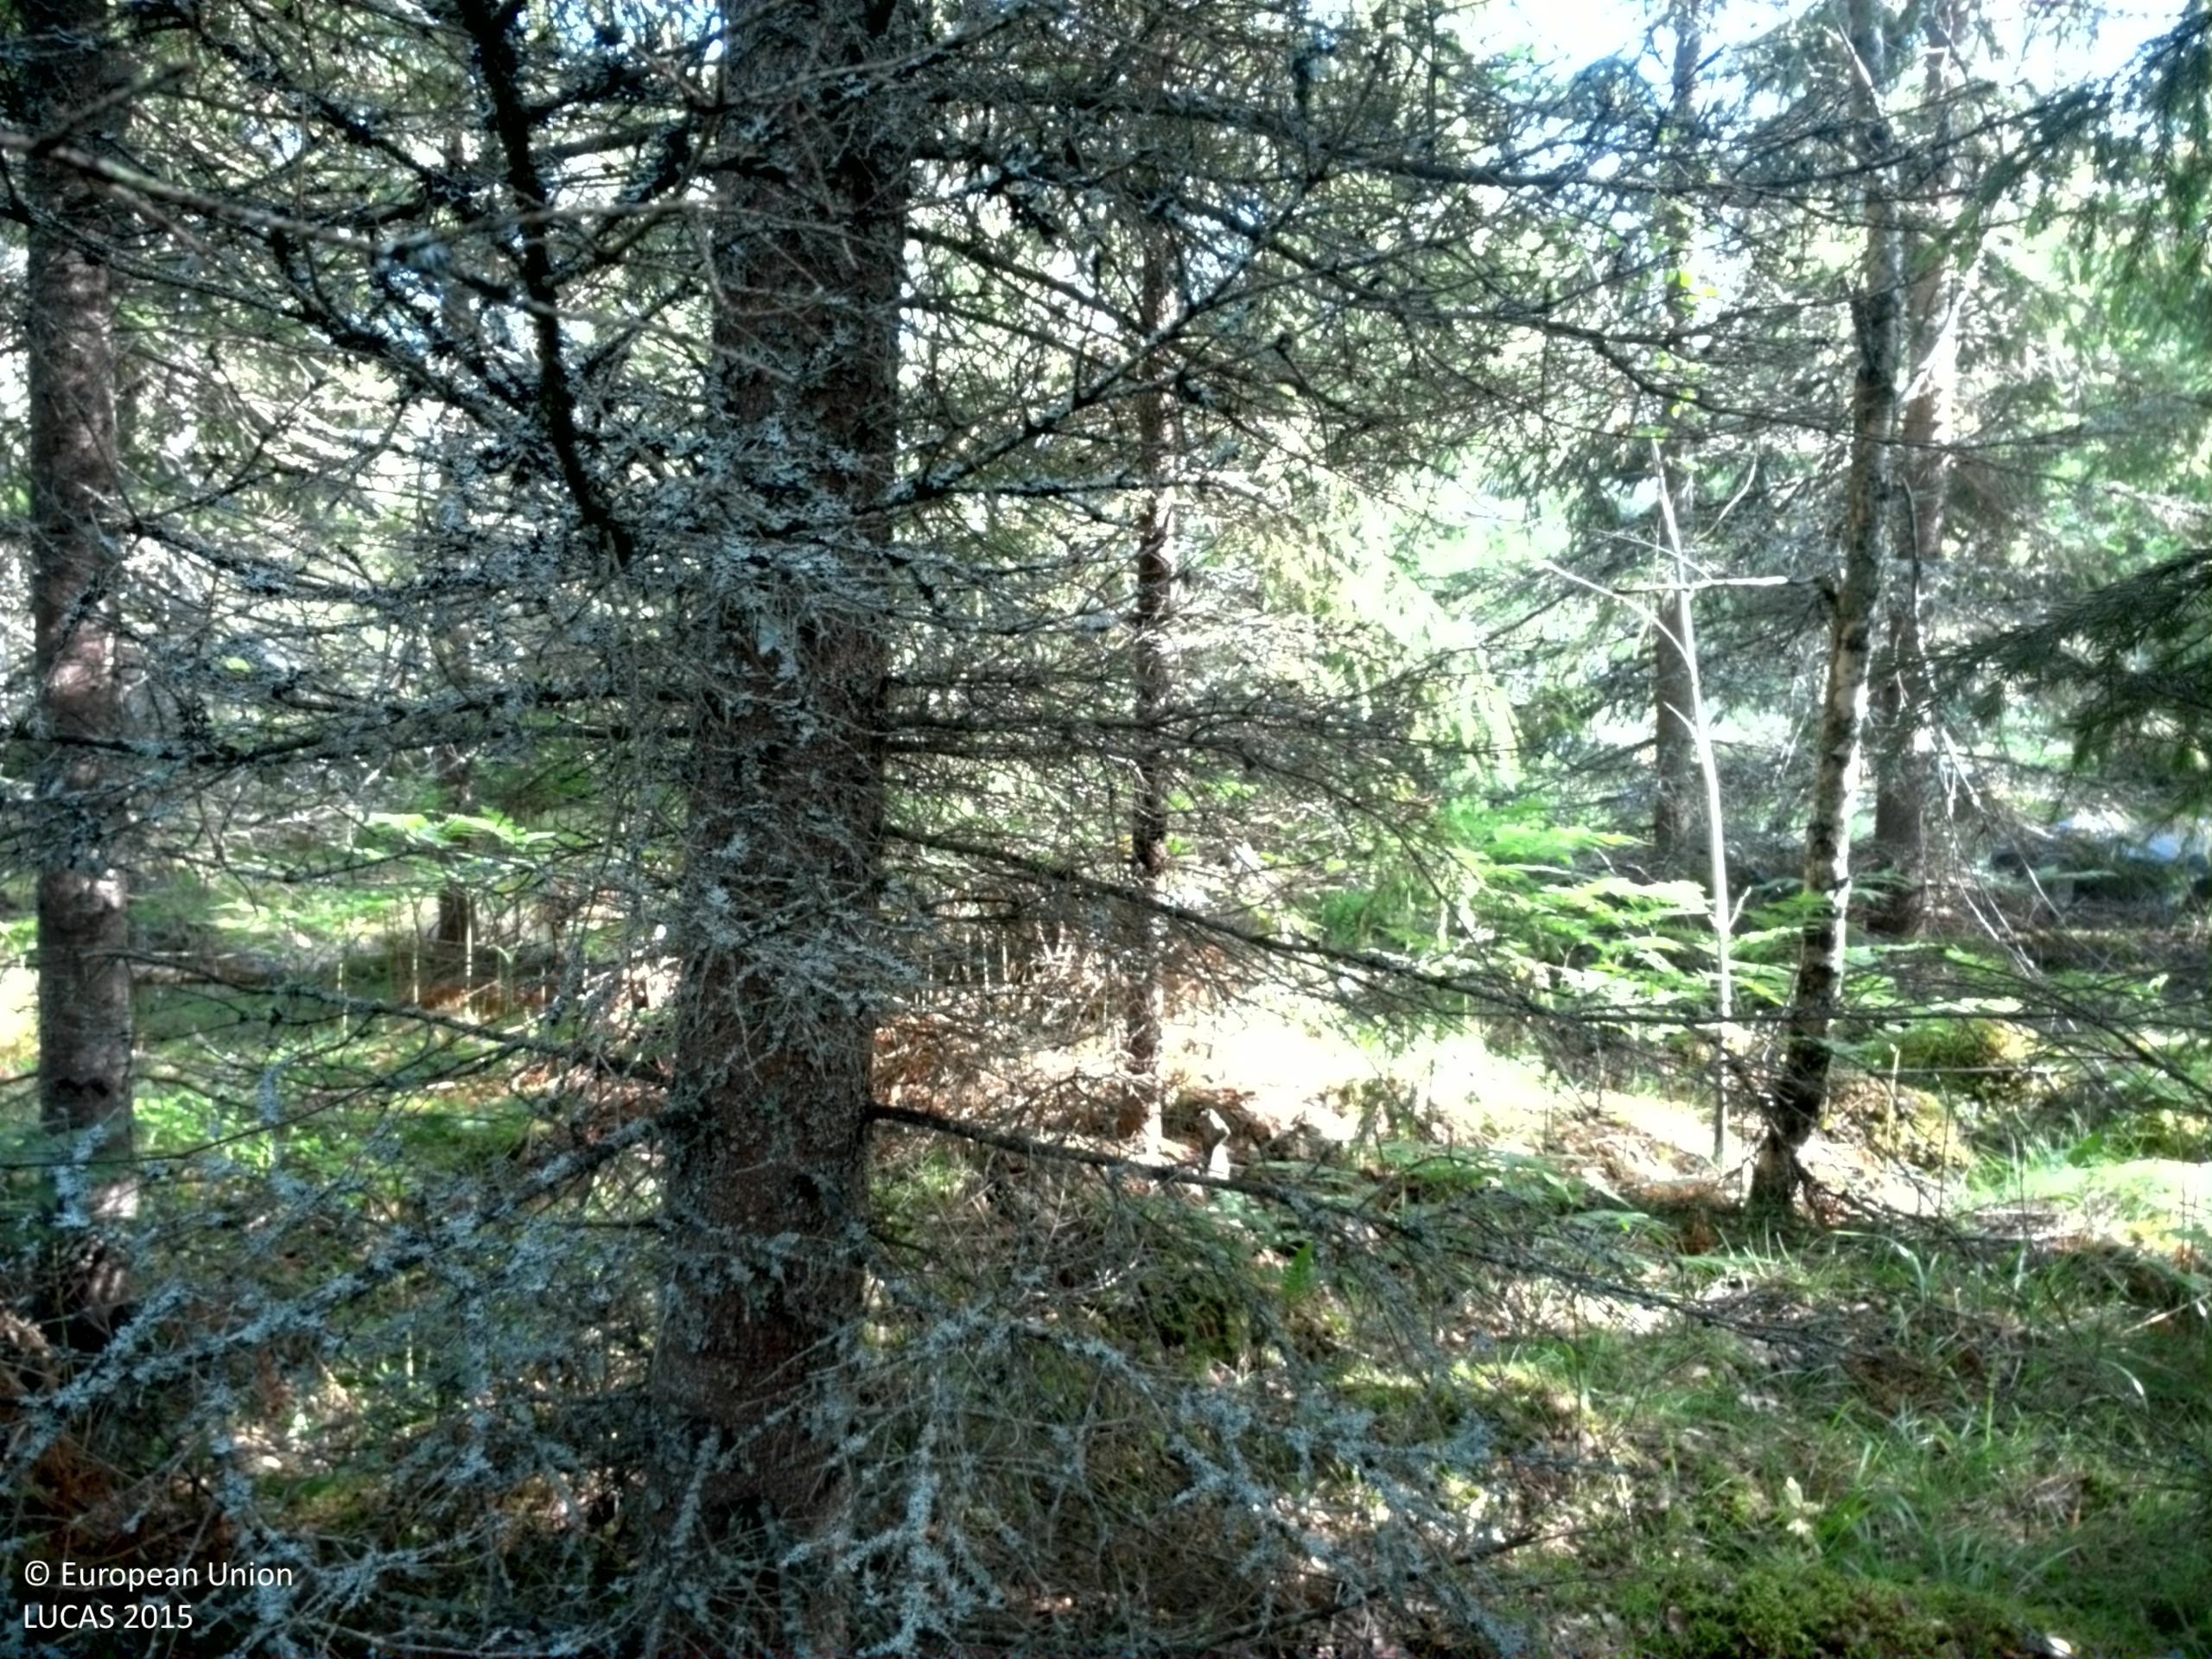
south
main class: Woodland
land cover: Spruce dominated coniferous woodland
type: boreal forest
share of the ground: > 75 %
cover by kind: coniferous forest trees 75 %, shrubs 10 %, lichens and mosses 10 %, herbaceous plants 5 %
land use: Forestry
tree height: > 5 m
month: June
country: SE
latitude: 60.3704
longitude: 17.6624
